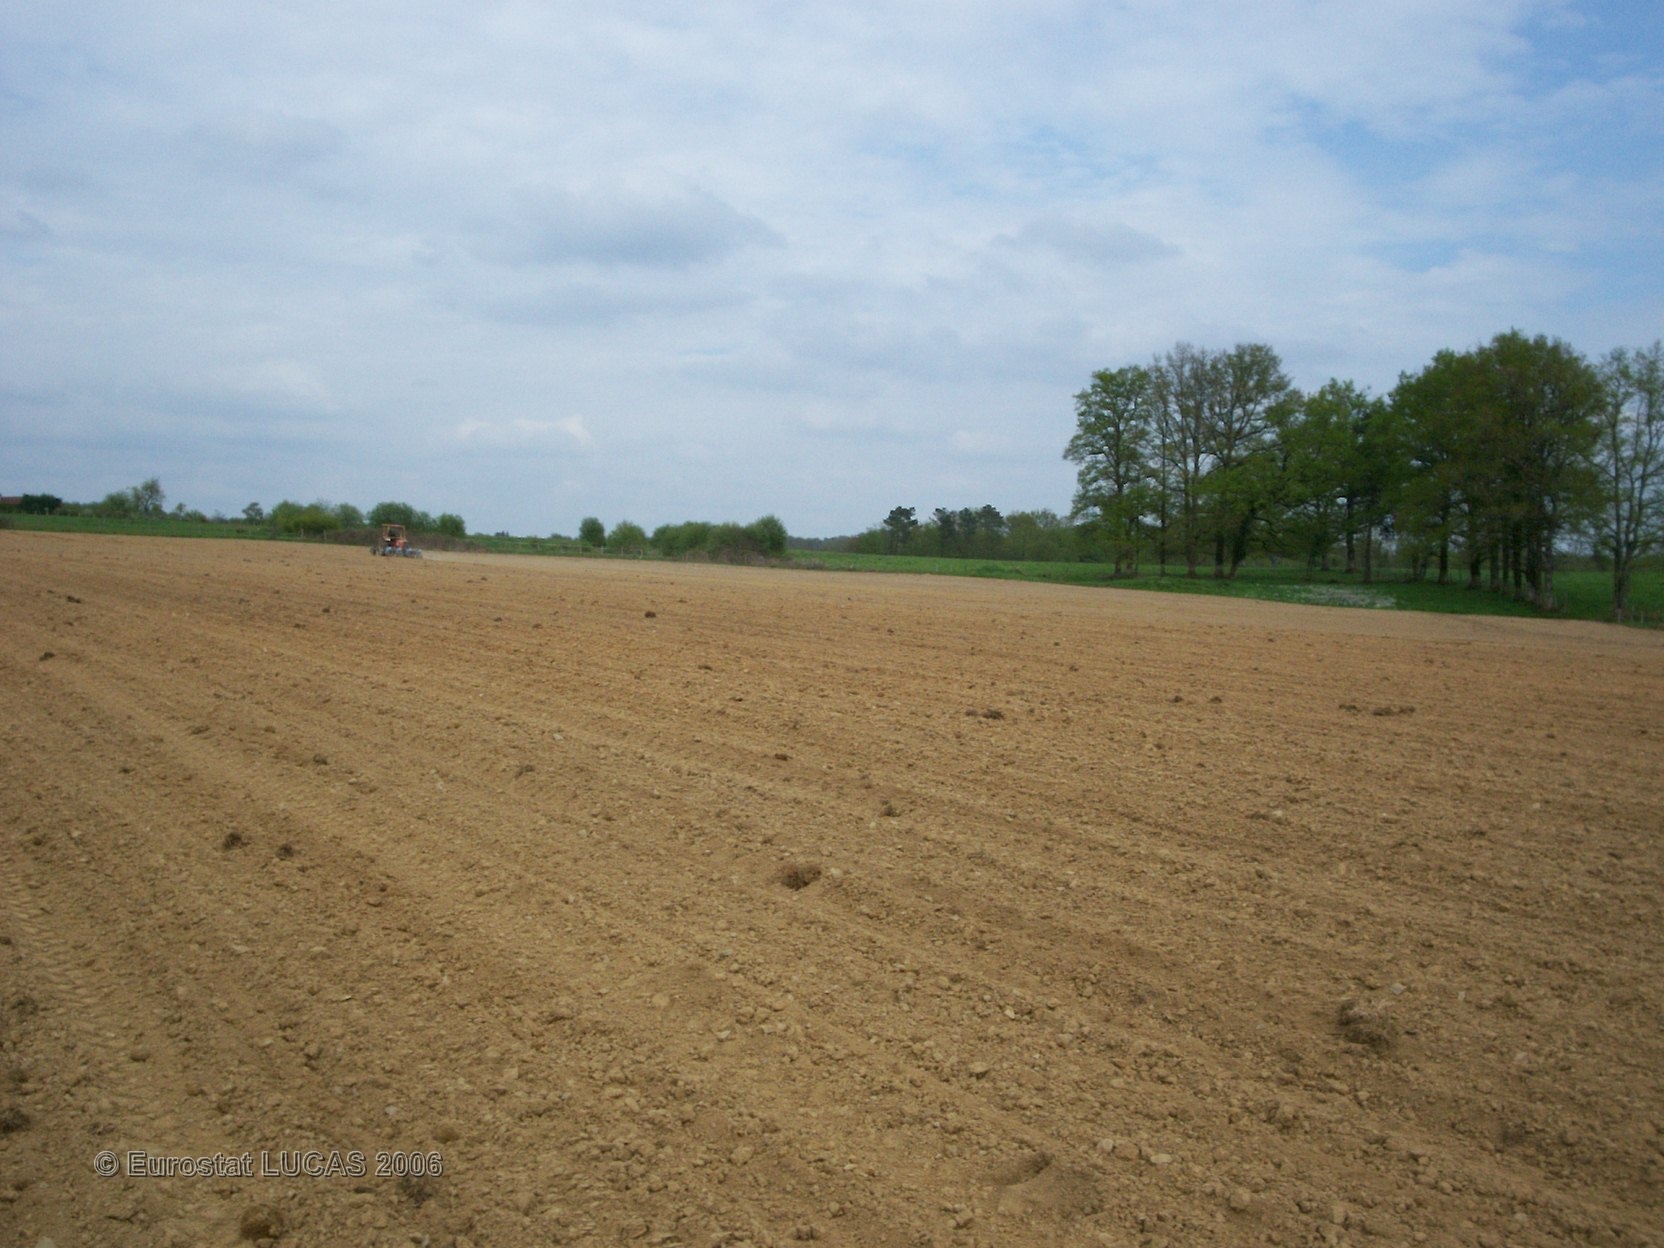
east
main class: Bare land
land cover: Bare land
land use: Agriculture (excluding fallow land and kitchen gardens)
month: April
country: FR
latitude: 45.4998
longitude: 0.7876
